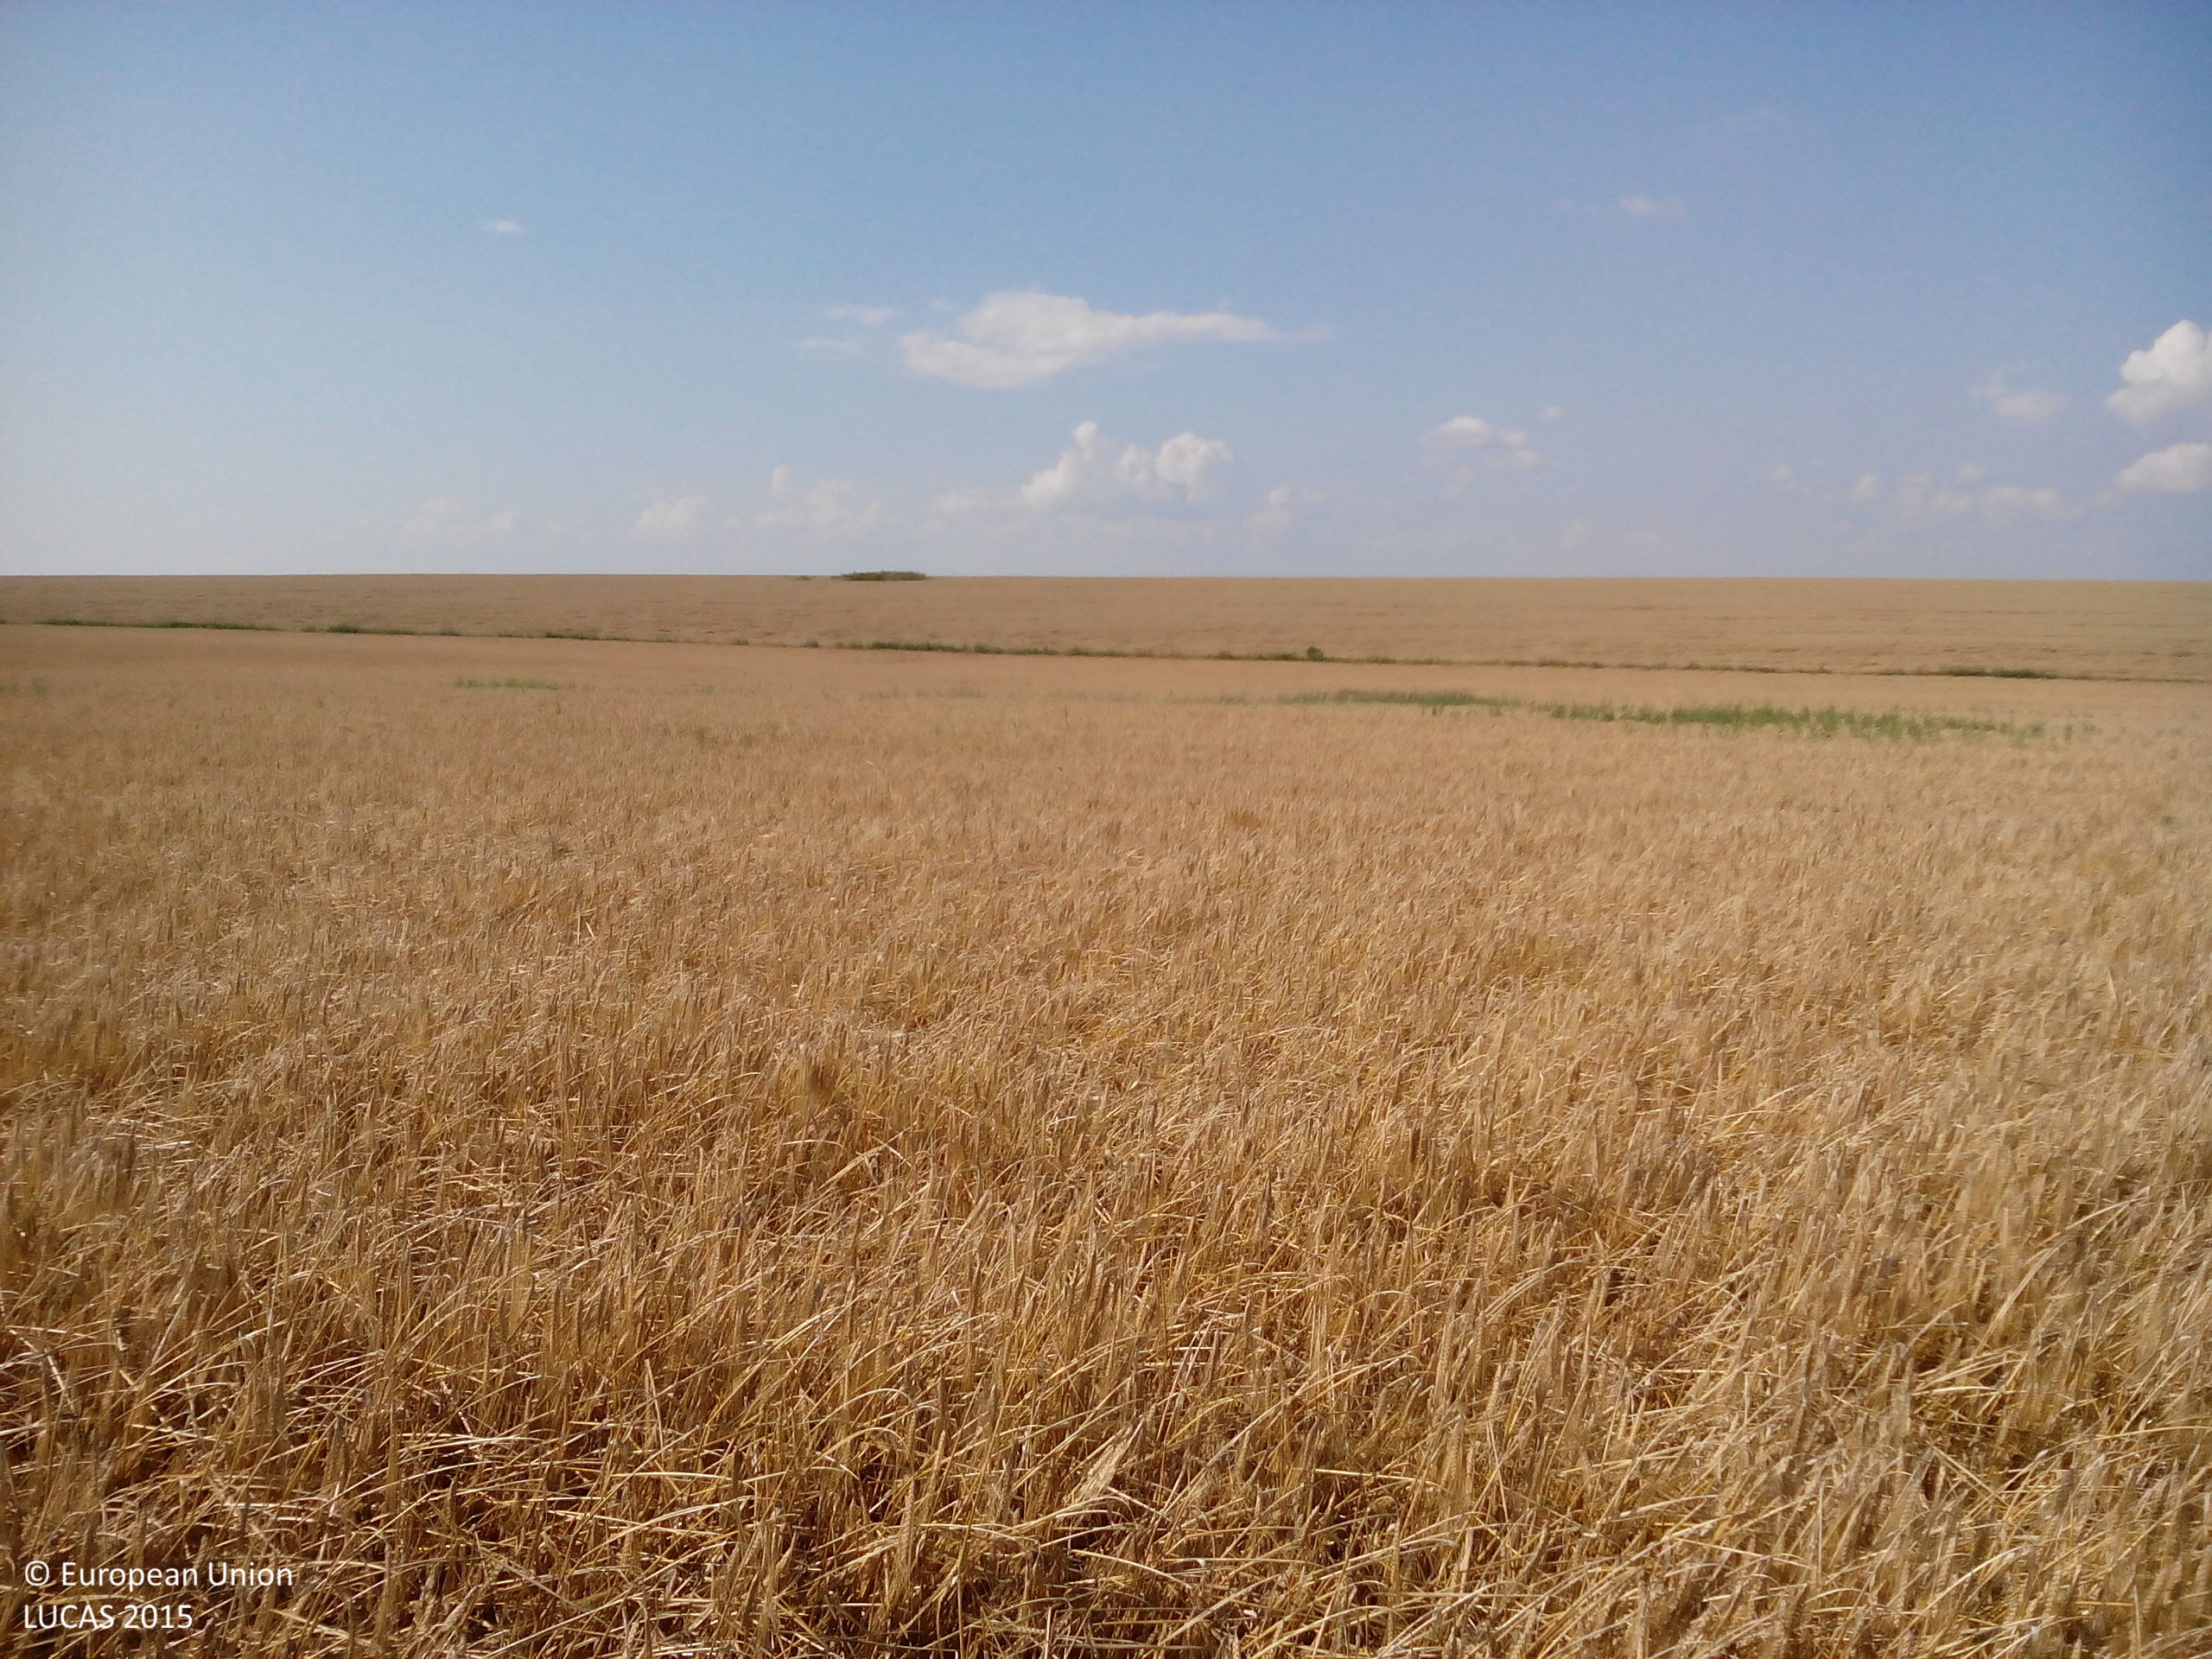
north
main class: Cropland
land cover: Barley
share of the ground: > 75 %
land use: Agriculture (excluding fallow land and kitchen gardens)
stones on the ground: < 10 %
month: July
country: BG
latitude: 43.4382
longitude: 24.3529
